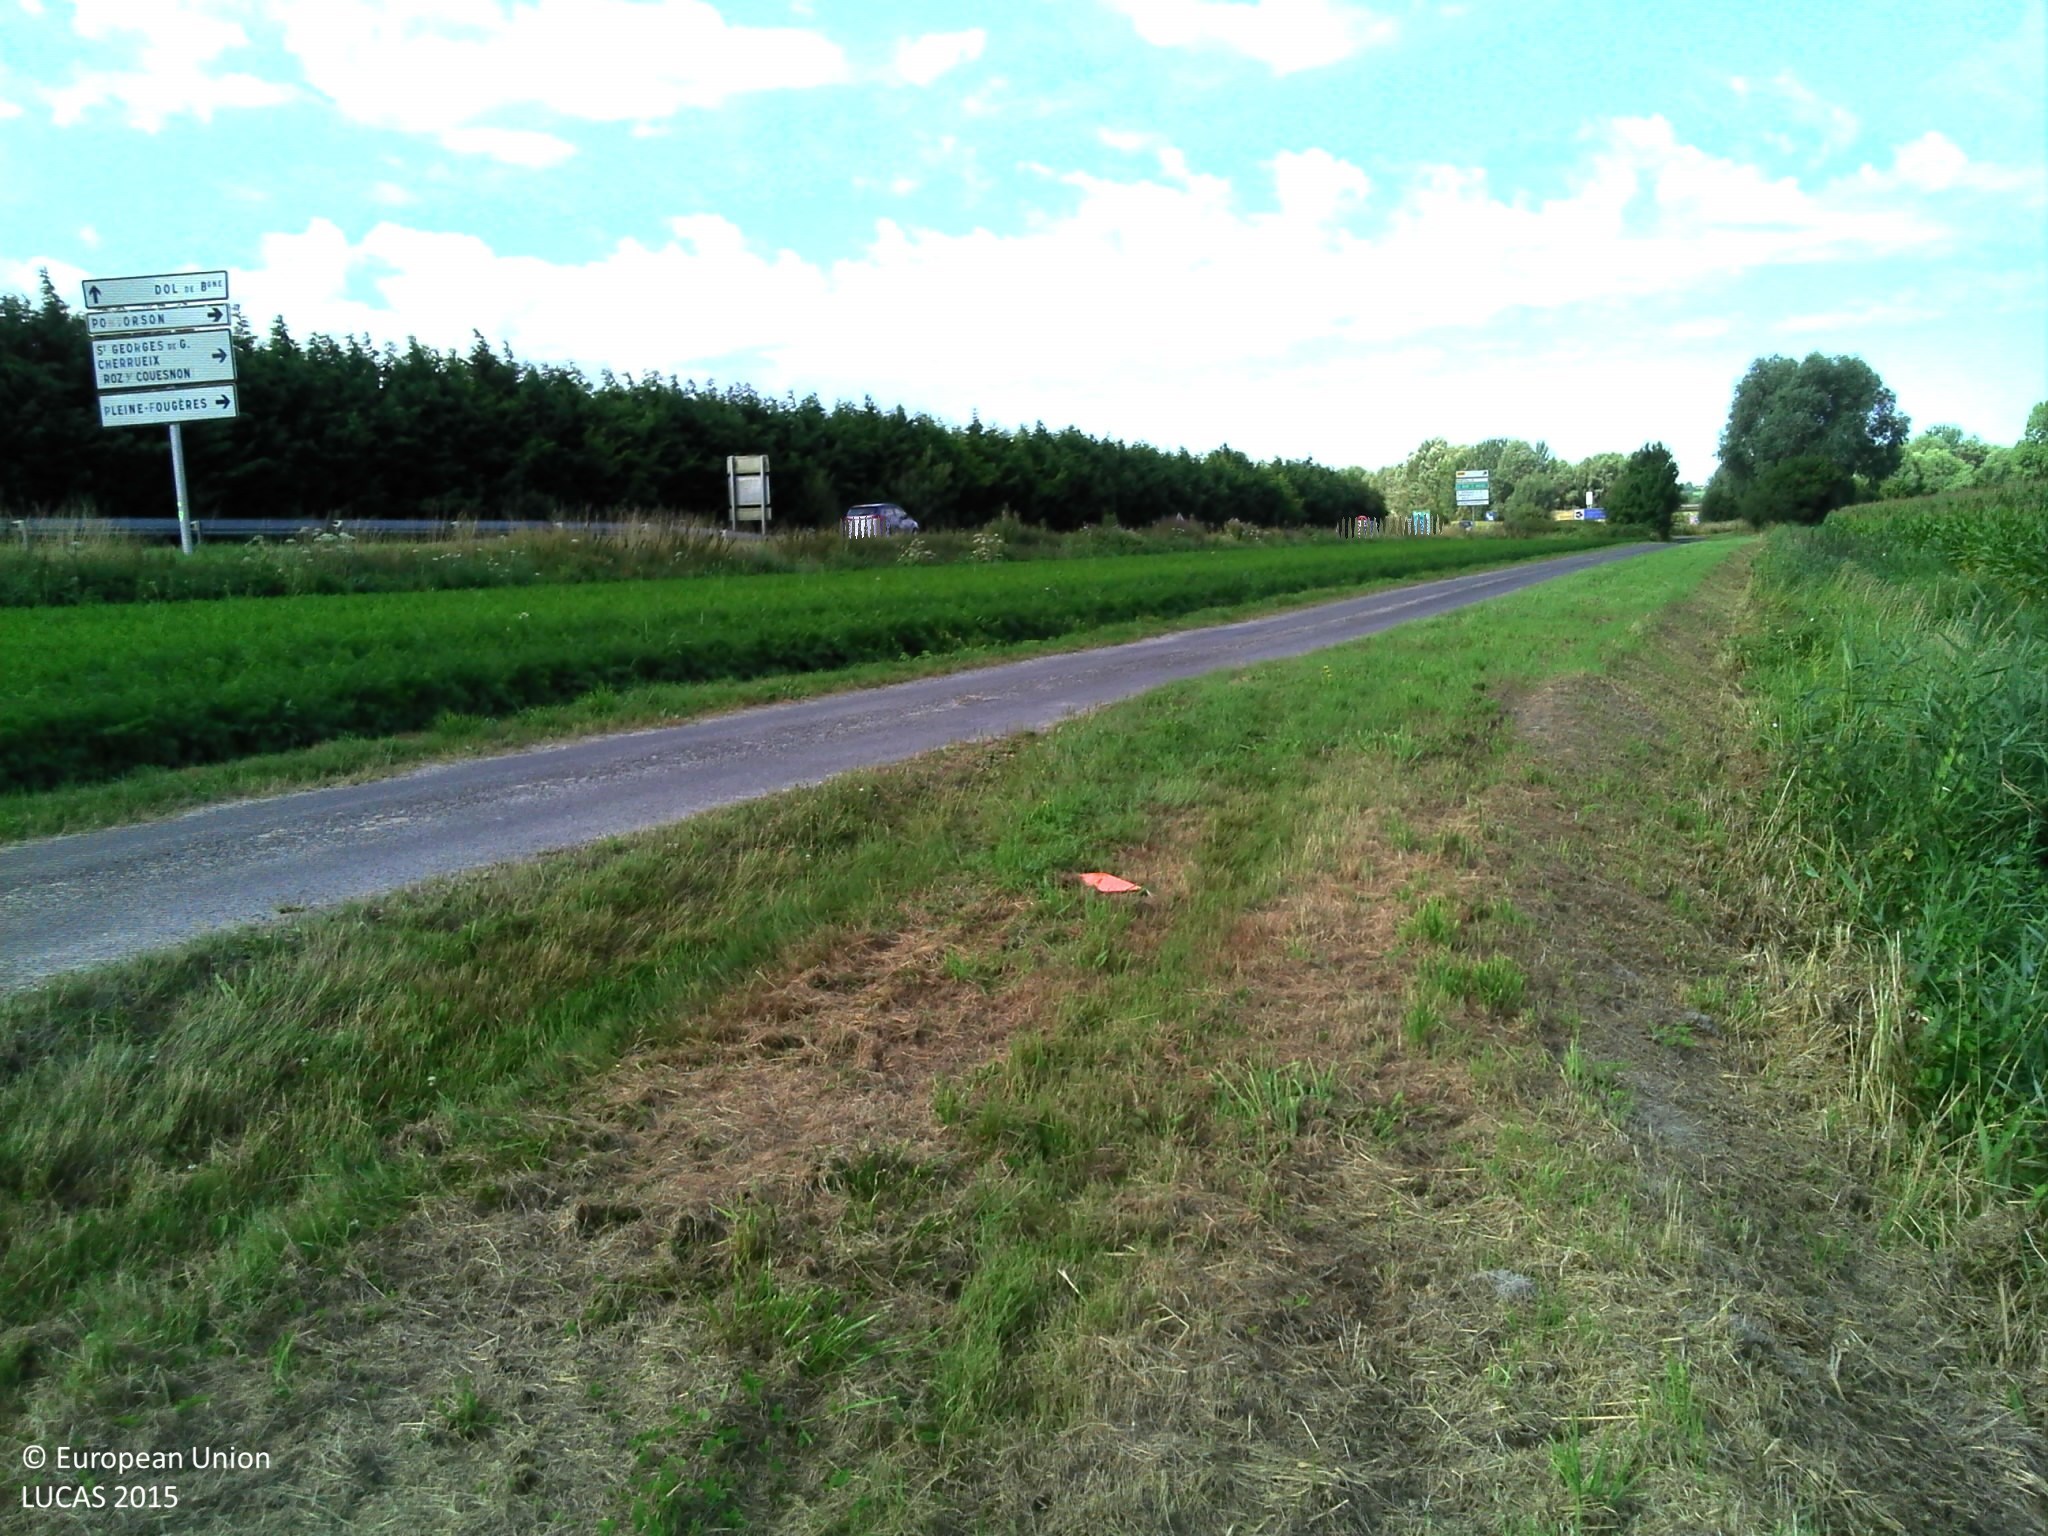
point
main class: Grassland
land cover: Grassland without tree/shrub cover
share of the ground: > 75 %
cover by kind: herbaceous plants 100 %
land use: Road transport
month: August
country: FR
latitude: 48.5619
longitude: -1.5246
